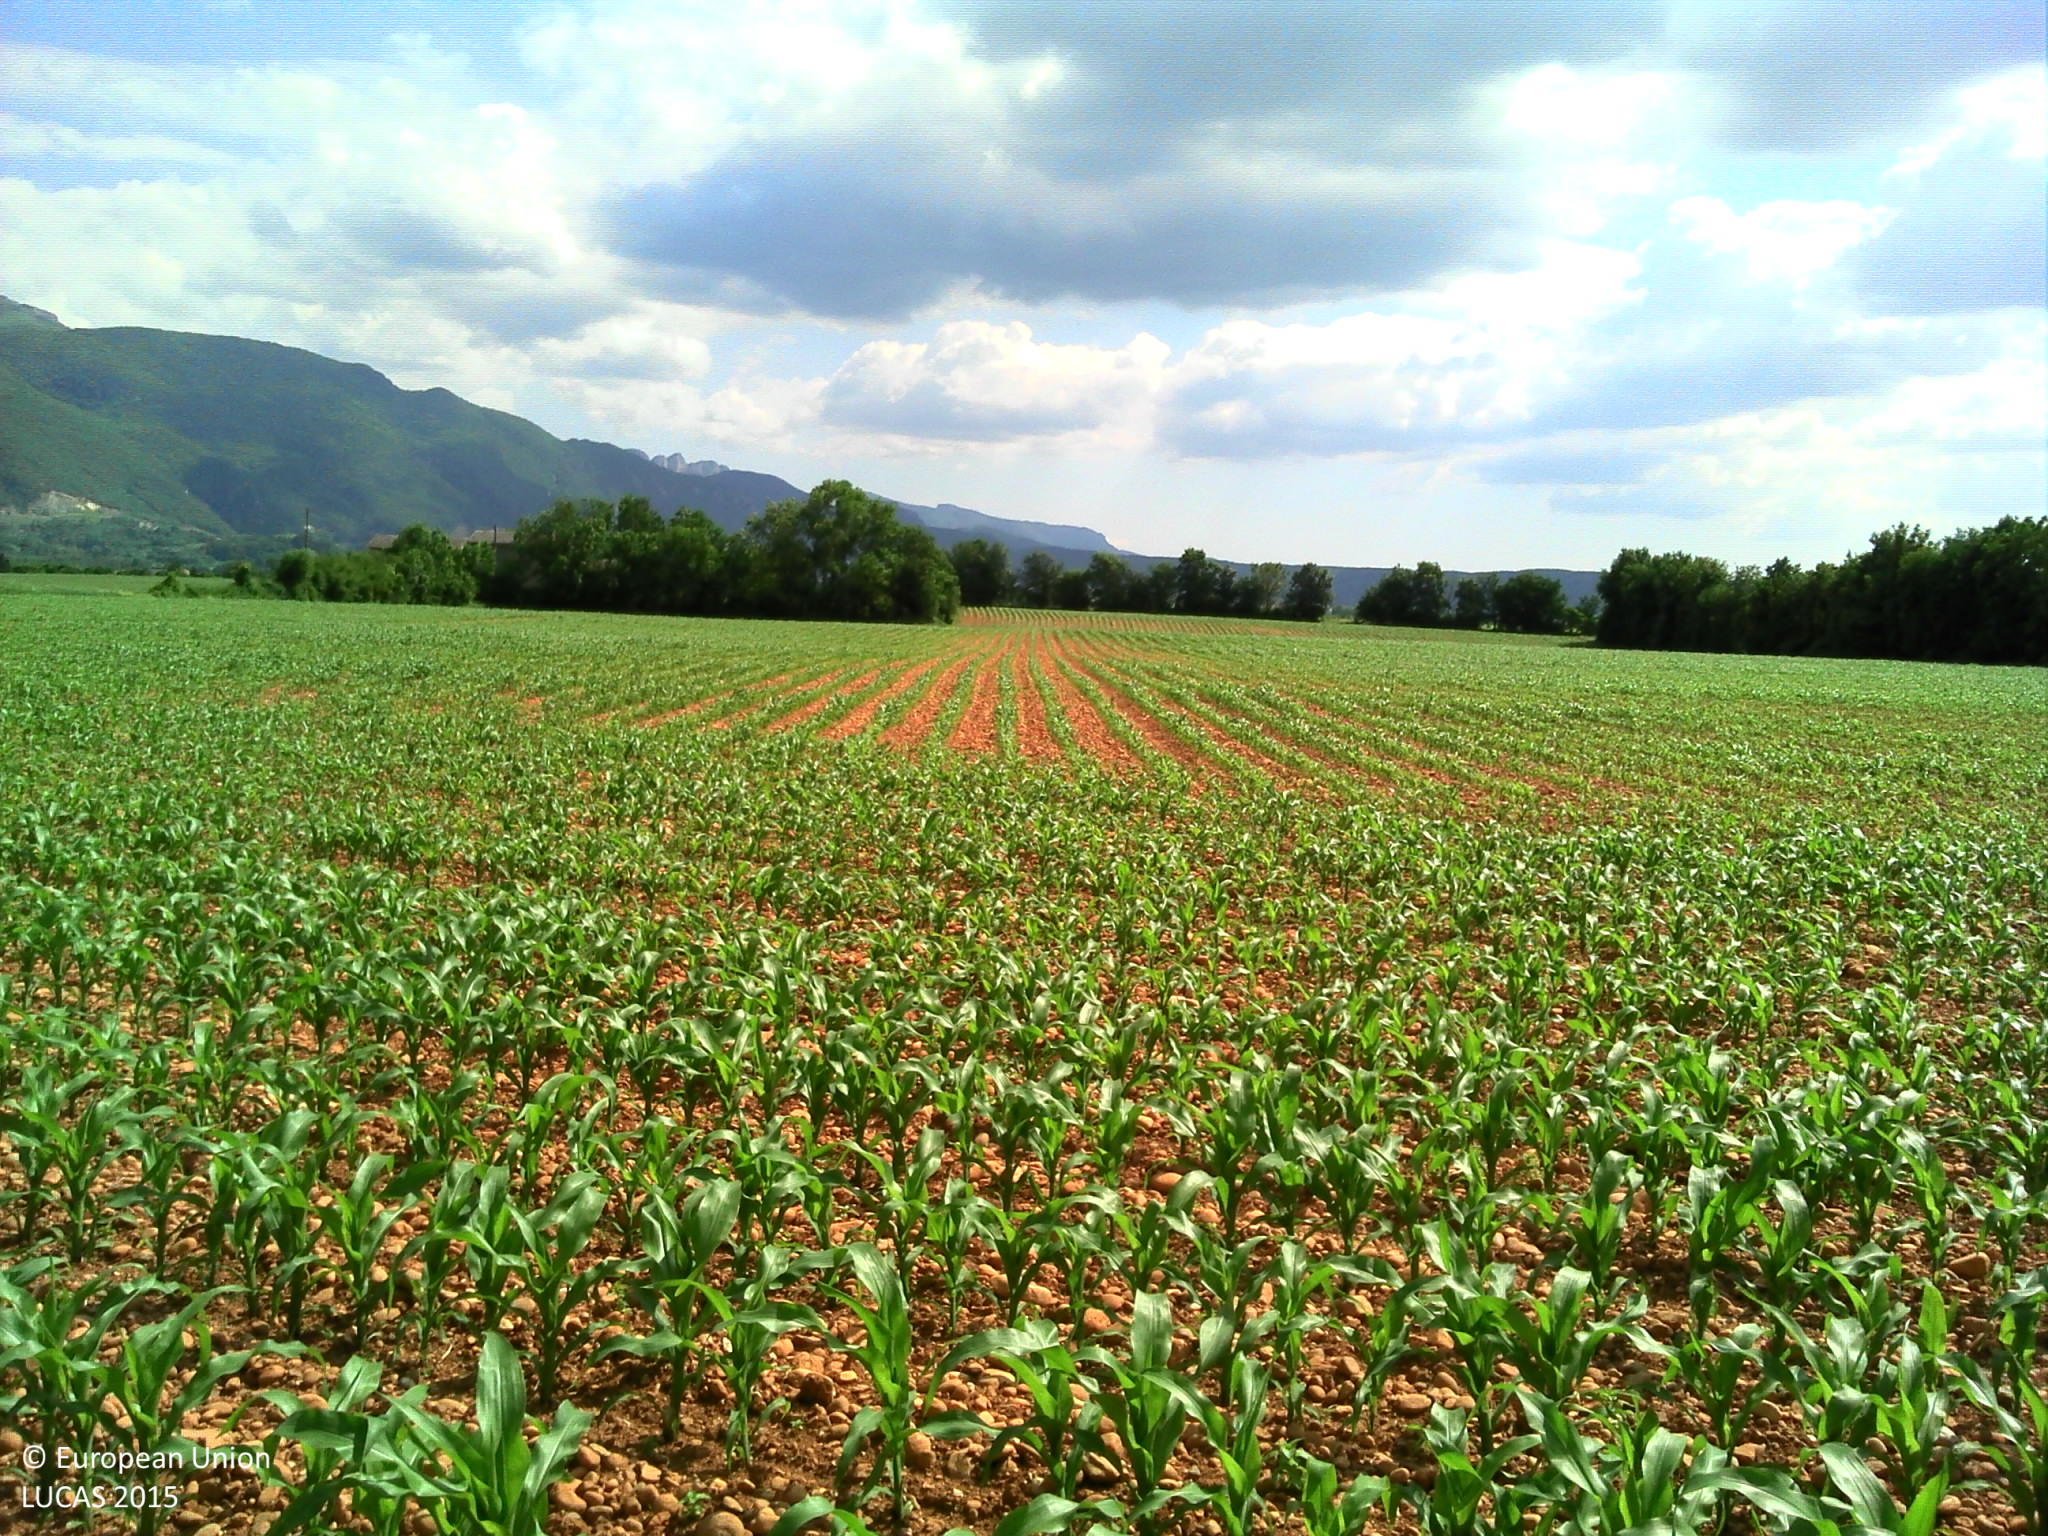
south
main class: Cropland
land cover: Maize
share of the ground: 10 - 25 %
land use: Agriculture (excluding fallow land and kitchen gardens)
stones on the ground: > 50 %
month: May
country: FR
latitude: 45.0699
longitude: 5.1917
